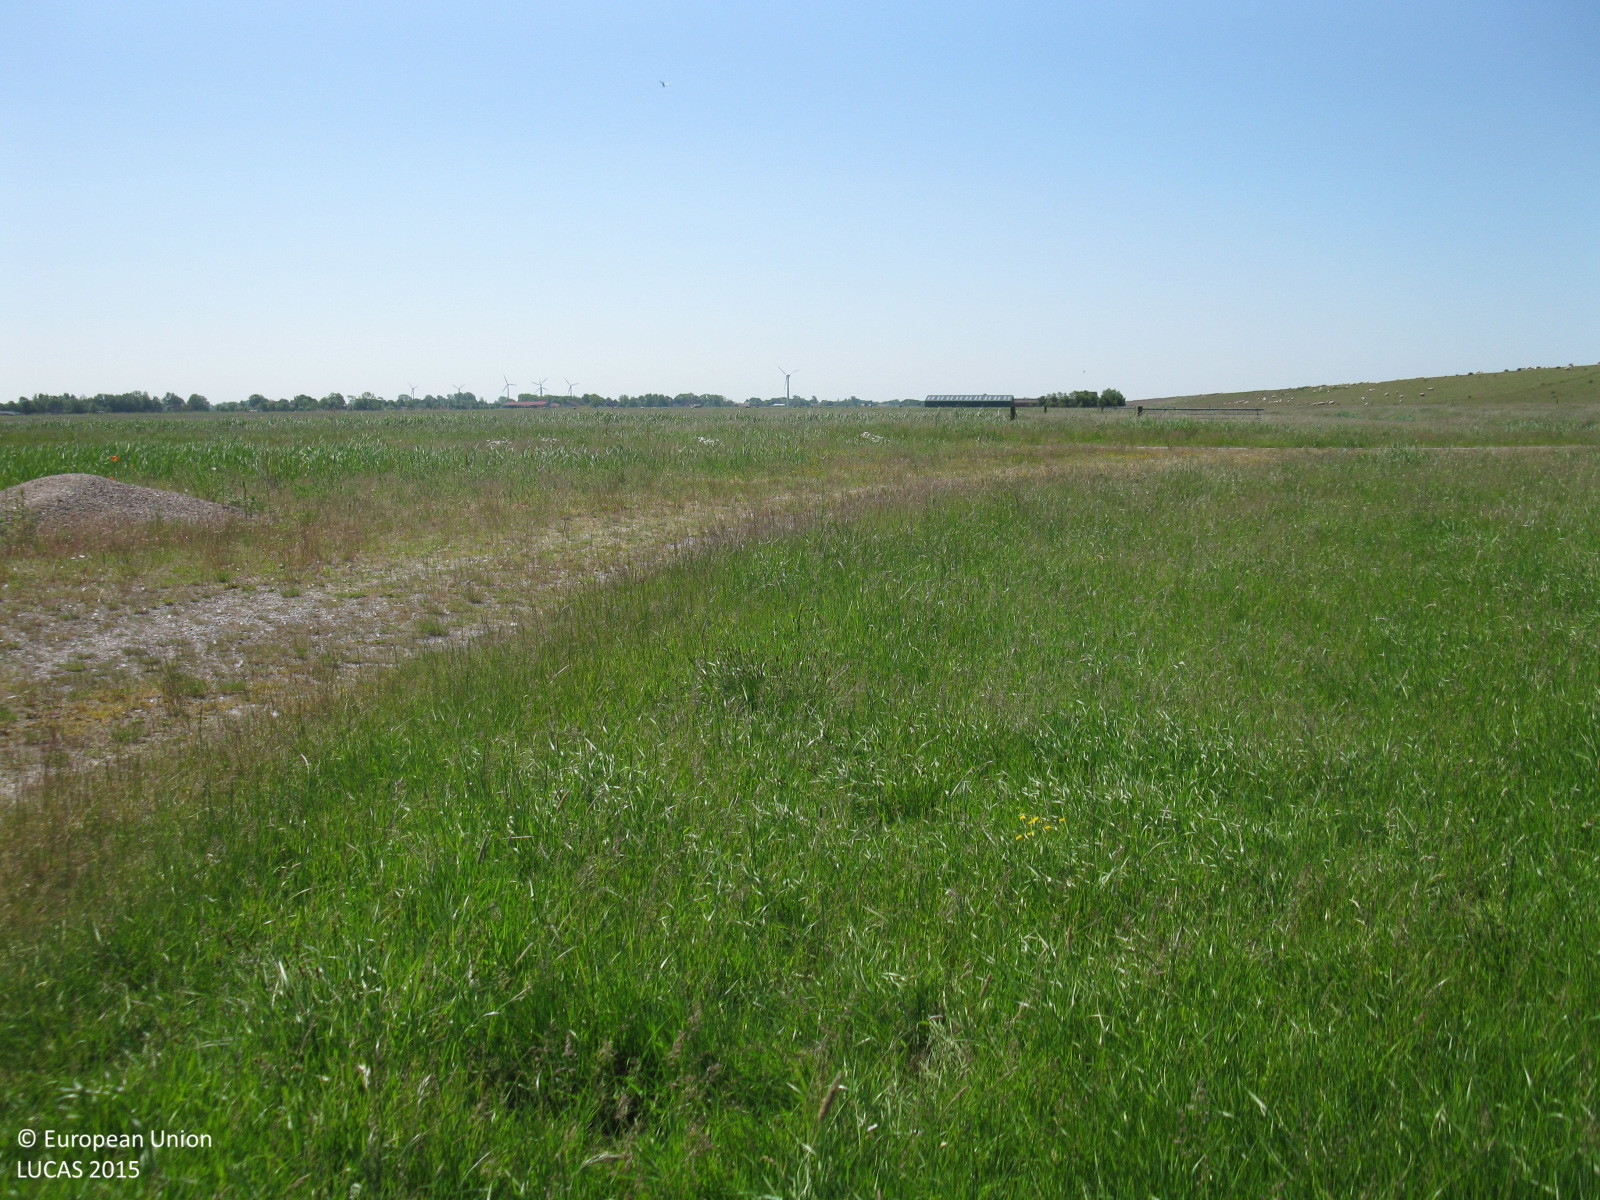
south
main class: Grassland
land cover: Grassland without tree/shrub cover
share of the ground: > 75 %
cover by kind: herbaceous plants 100 %
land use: Agriculture (excluding fallow land and kitchen gardens)
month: June
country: DE
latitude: 53.4982
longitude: 8.3274
